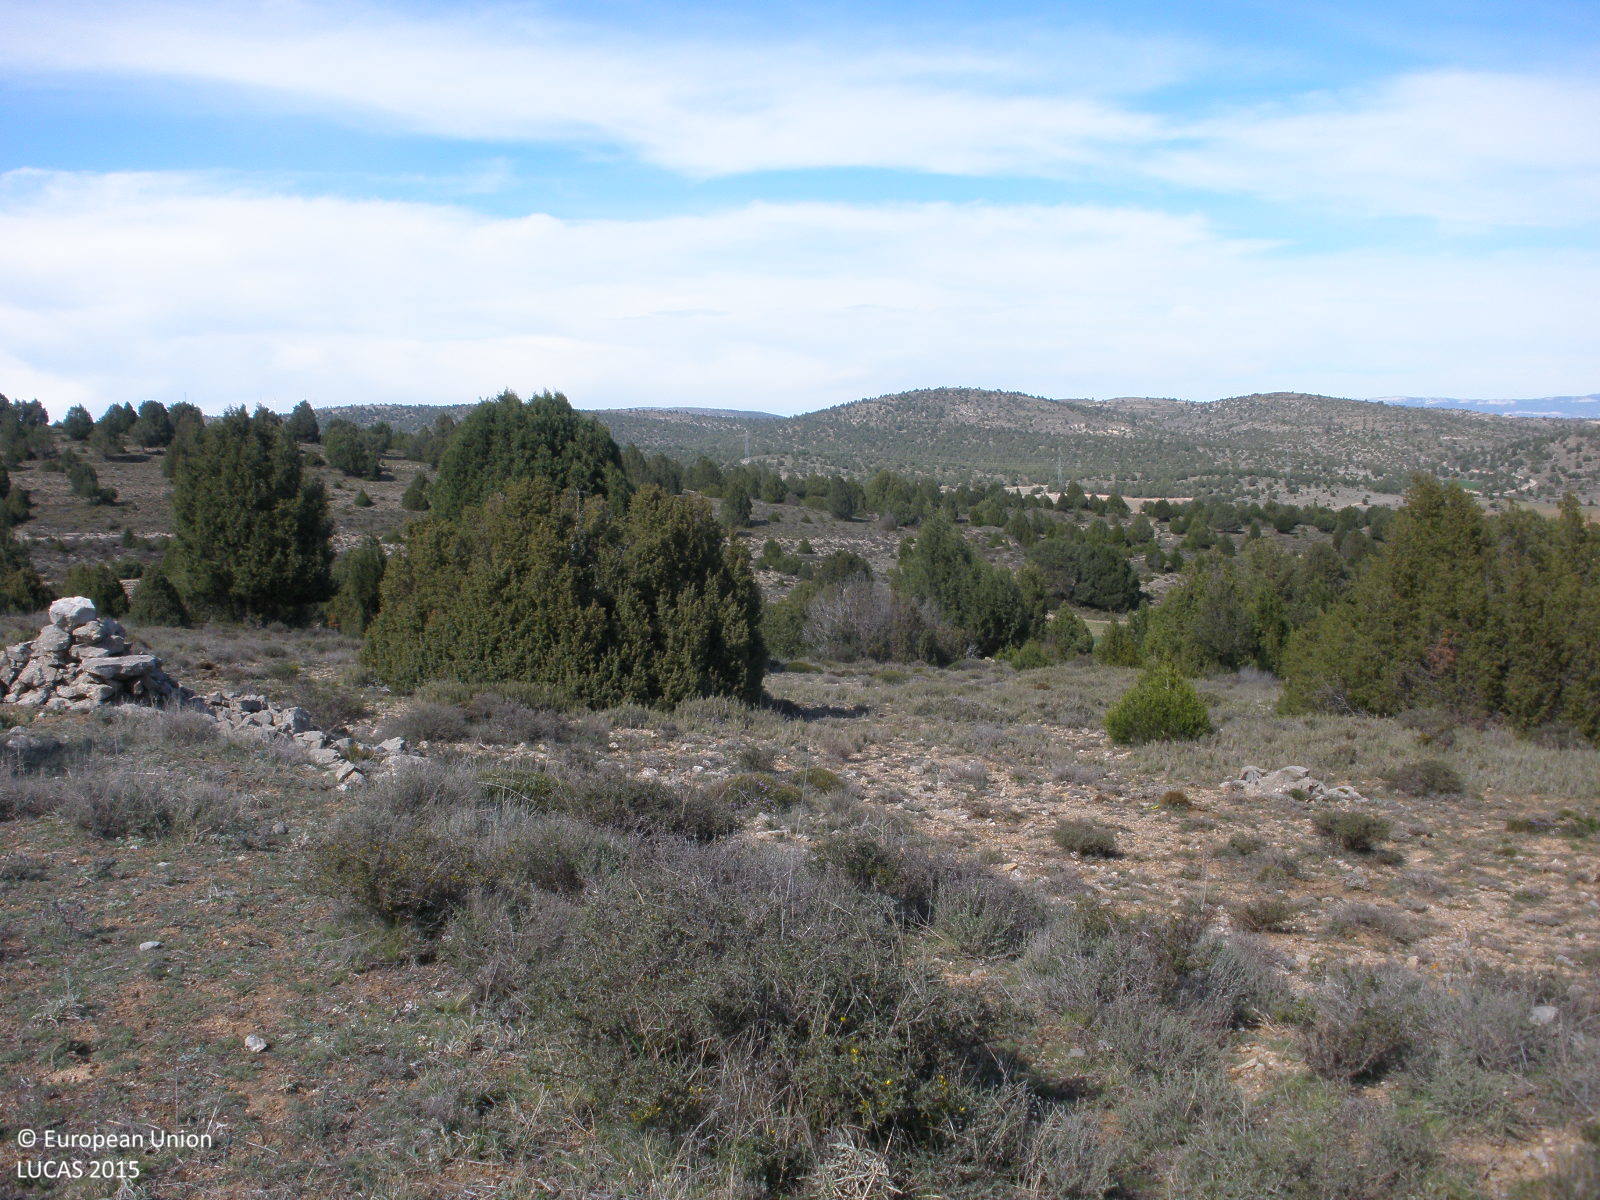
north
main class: Shrubland
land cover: Shrubland with sparse tree cover
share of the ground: 25 - 50 %
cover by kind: shrubs 40 %, consolidated bare surface 30 %, herbaceous plants 25 %, coniferous forest trees 5 %
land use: Agriculture (excluding fallow land and kitchen gardens)
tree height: < 5 m
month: April
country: ES
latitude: 40.2514
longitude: -0.9776
